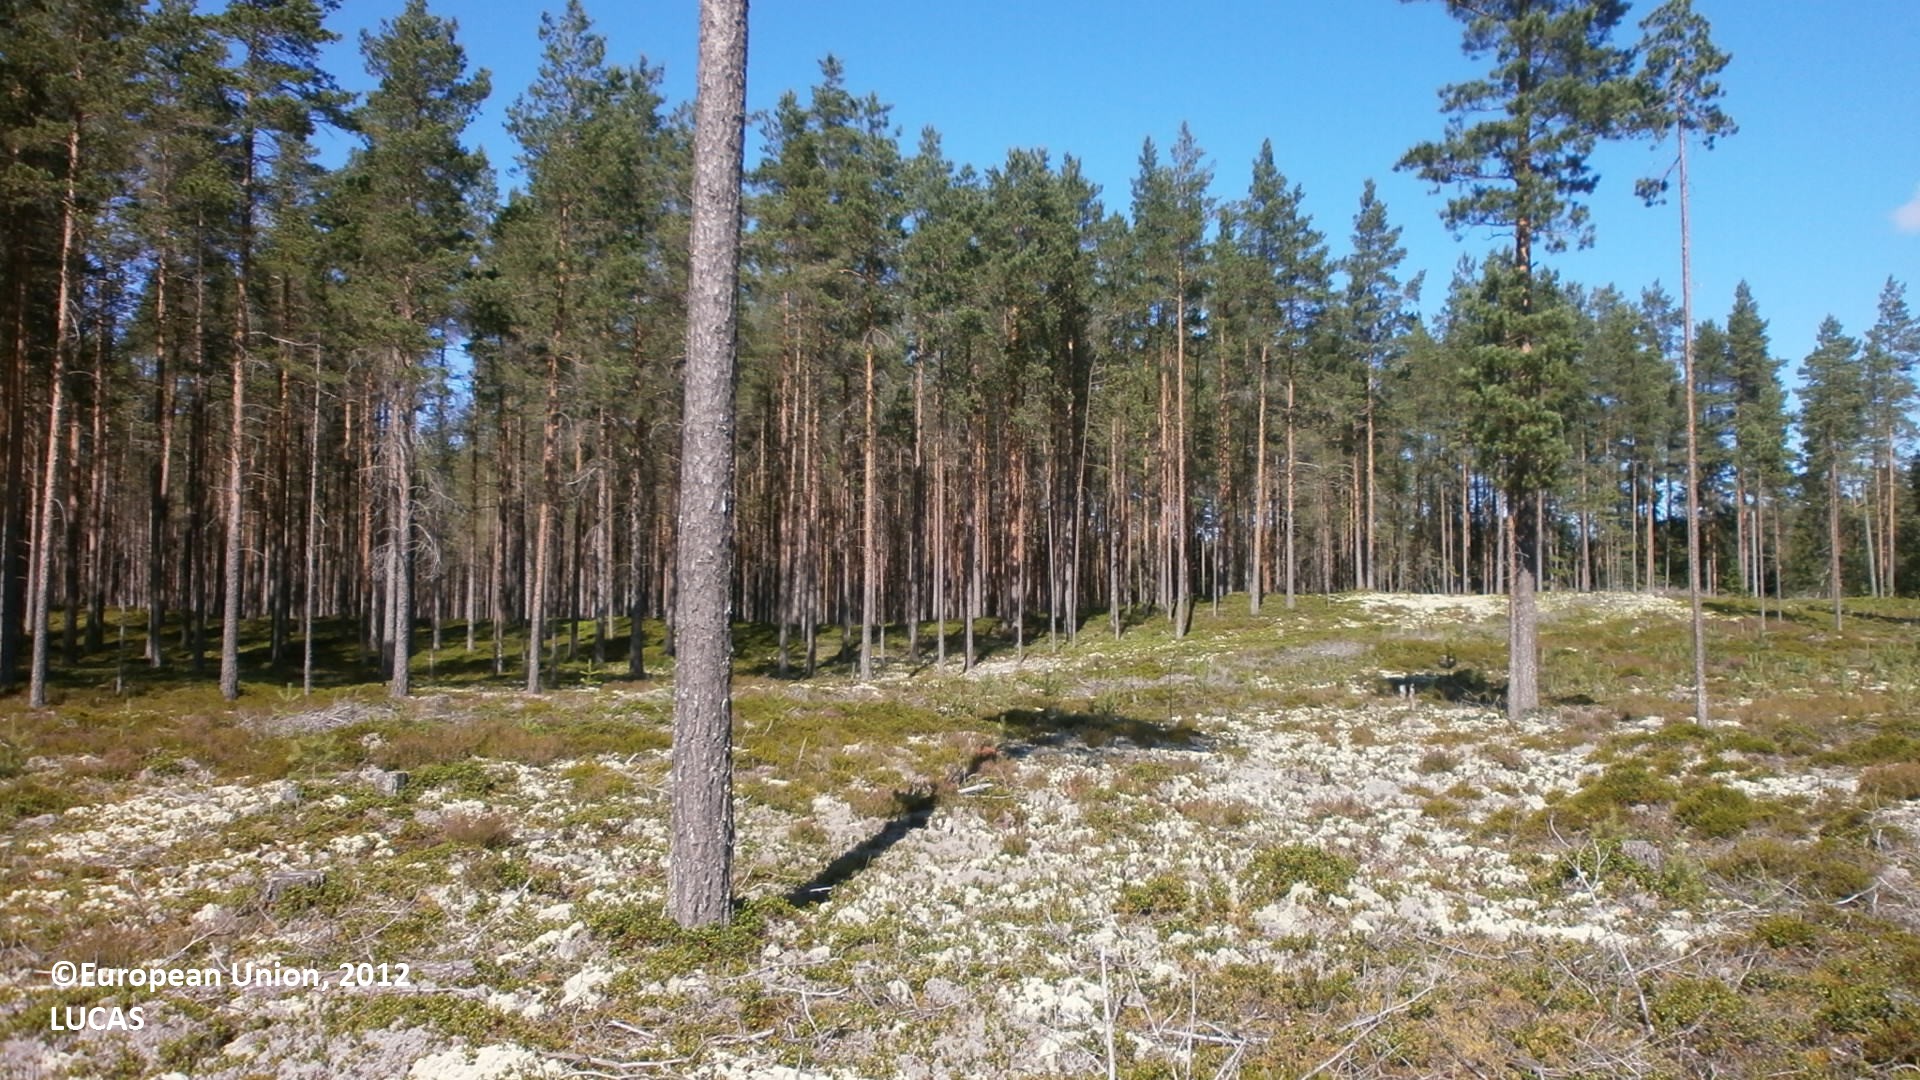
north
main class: Woodland
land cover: Pine dominated coniferous woodland
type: boreal forest
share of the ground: 10 - 25 %
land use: Forestry
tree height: > 5 m
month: July
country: FI
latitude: 64.1579
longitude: 23.8165
